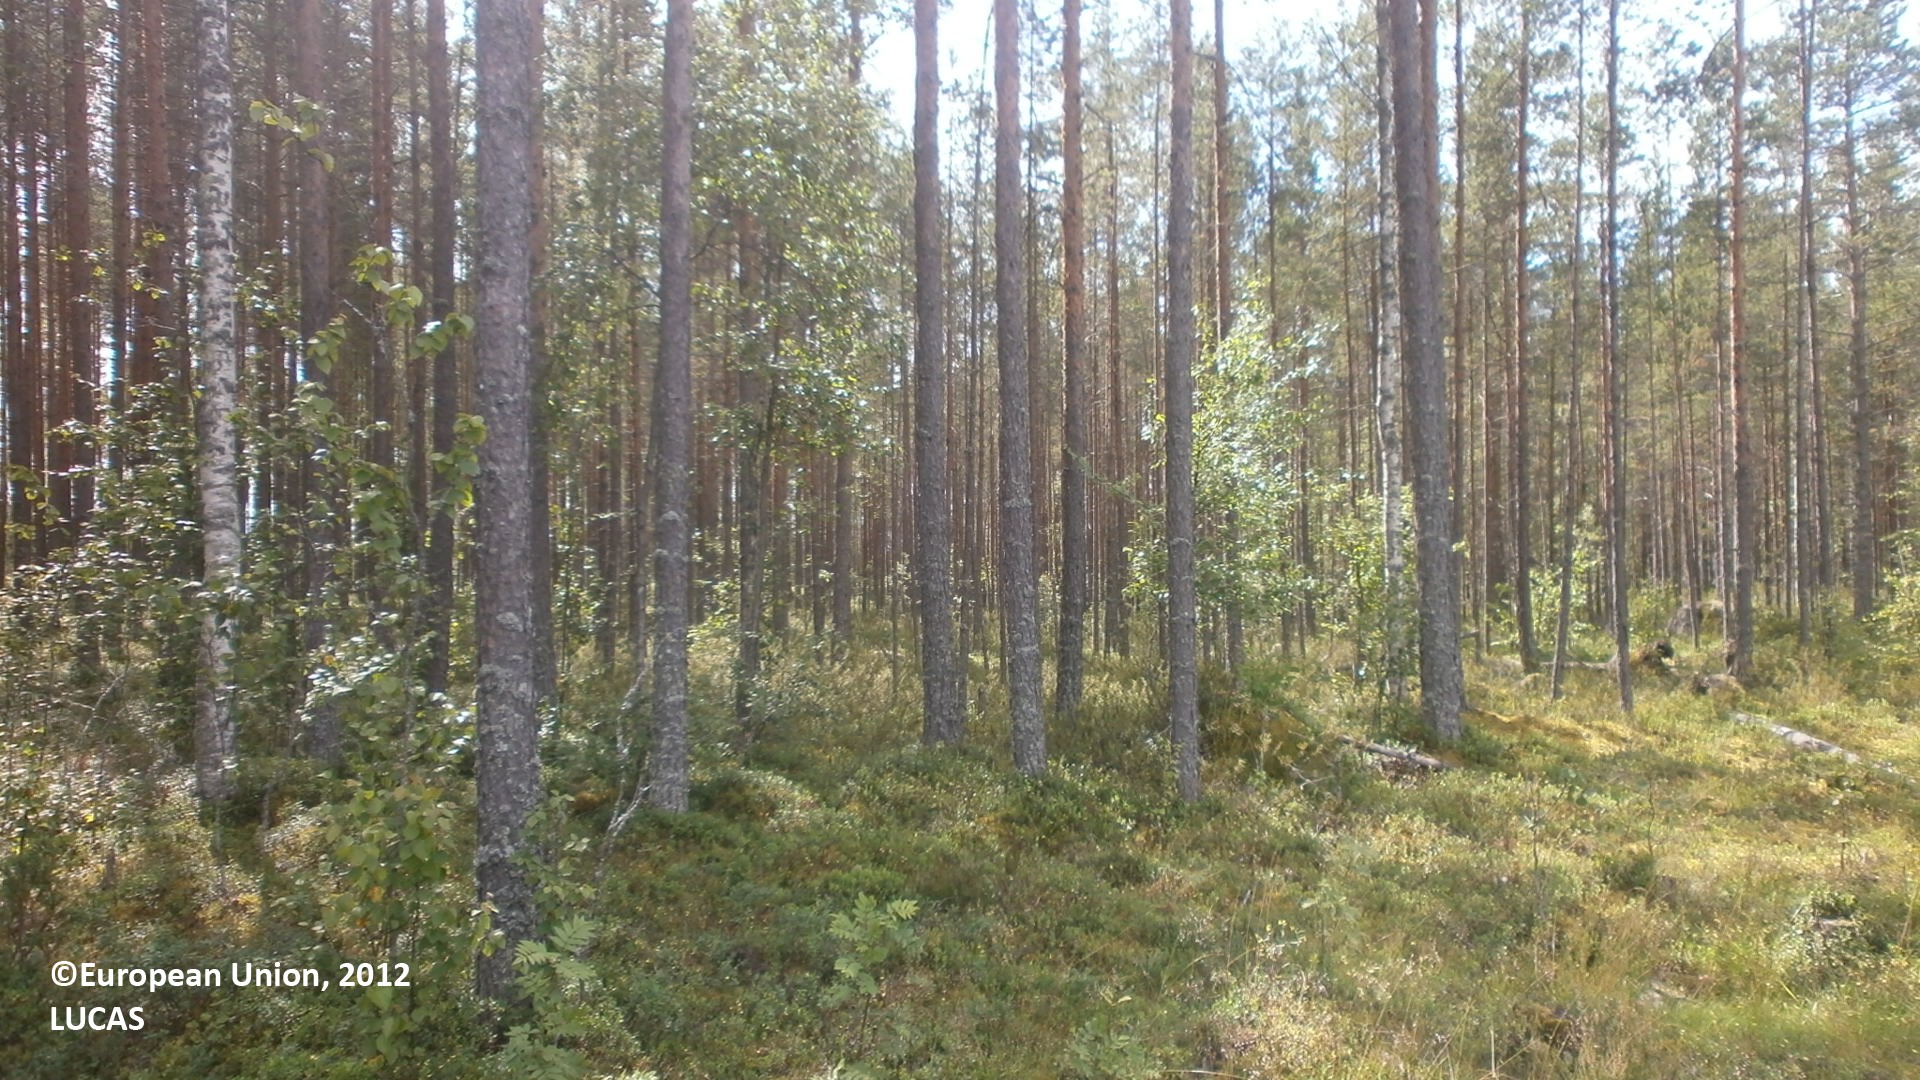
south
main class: Shrubland
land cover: Shrubland with sparse tree cover
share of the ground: > 75 %
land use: Forestry
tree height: < 5 m
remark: Clear cut
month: July
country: FI
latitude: 64.0443
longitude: 24.2611
